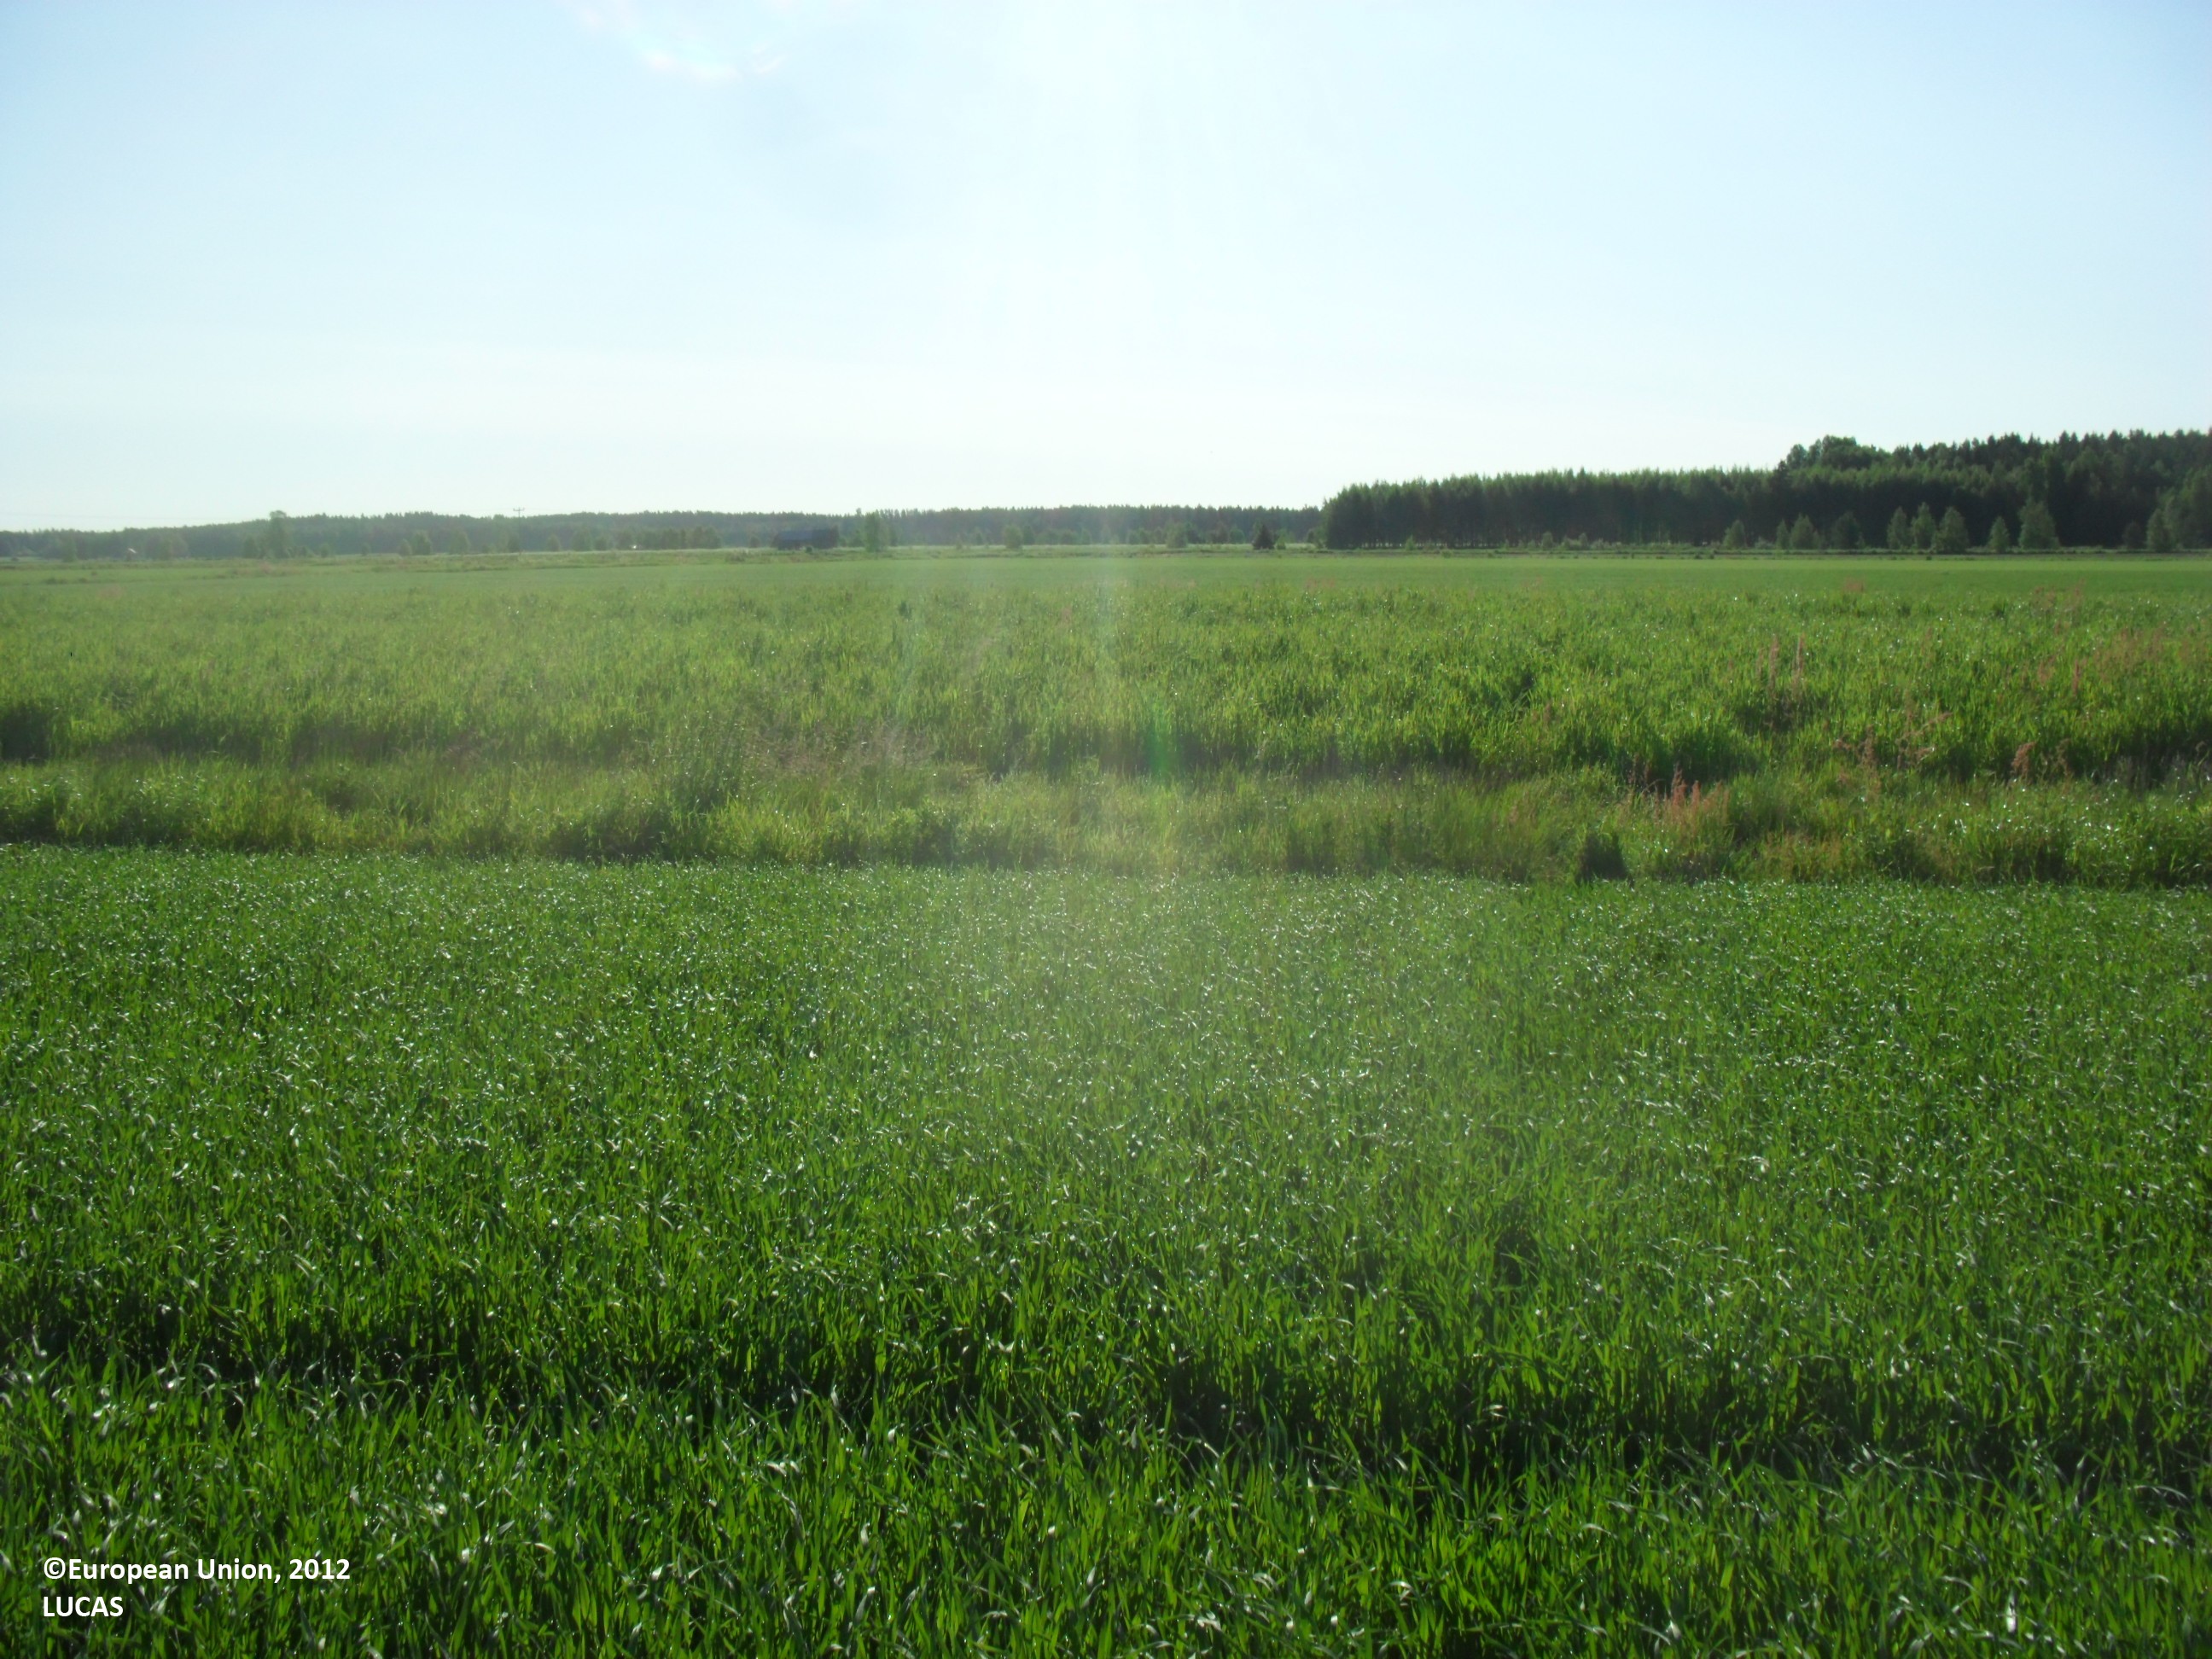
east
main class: Cropland
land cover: Oats
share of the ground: > 75 %
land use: Agriculture (excluding fallow land and kitchen gardens)
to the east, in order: Oats; Temporary grasslands; Oats; Barley; Ditches and canals
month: June
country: FI
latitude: 63.0768
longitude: 22.9442
